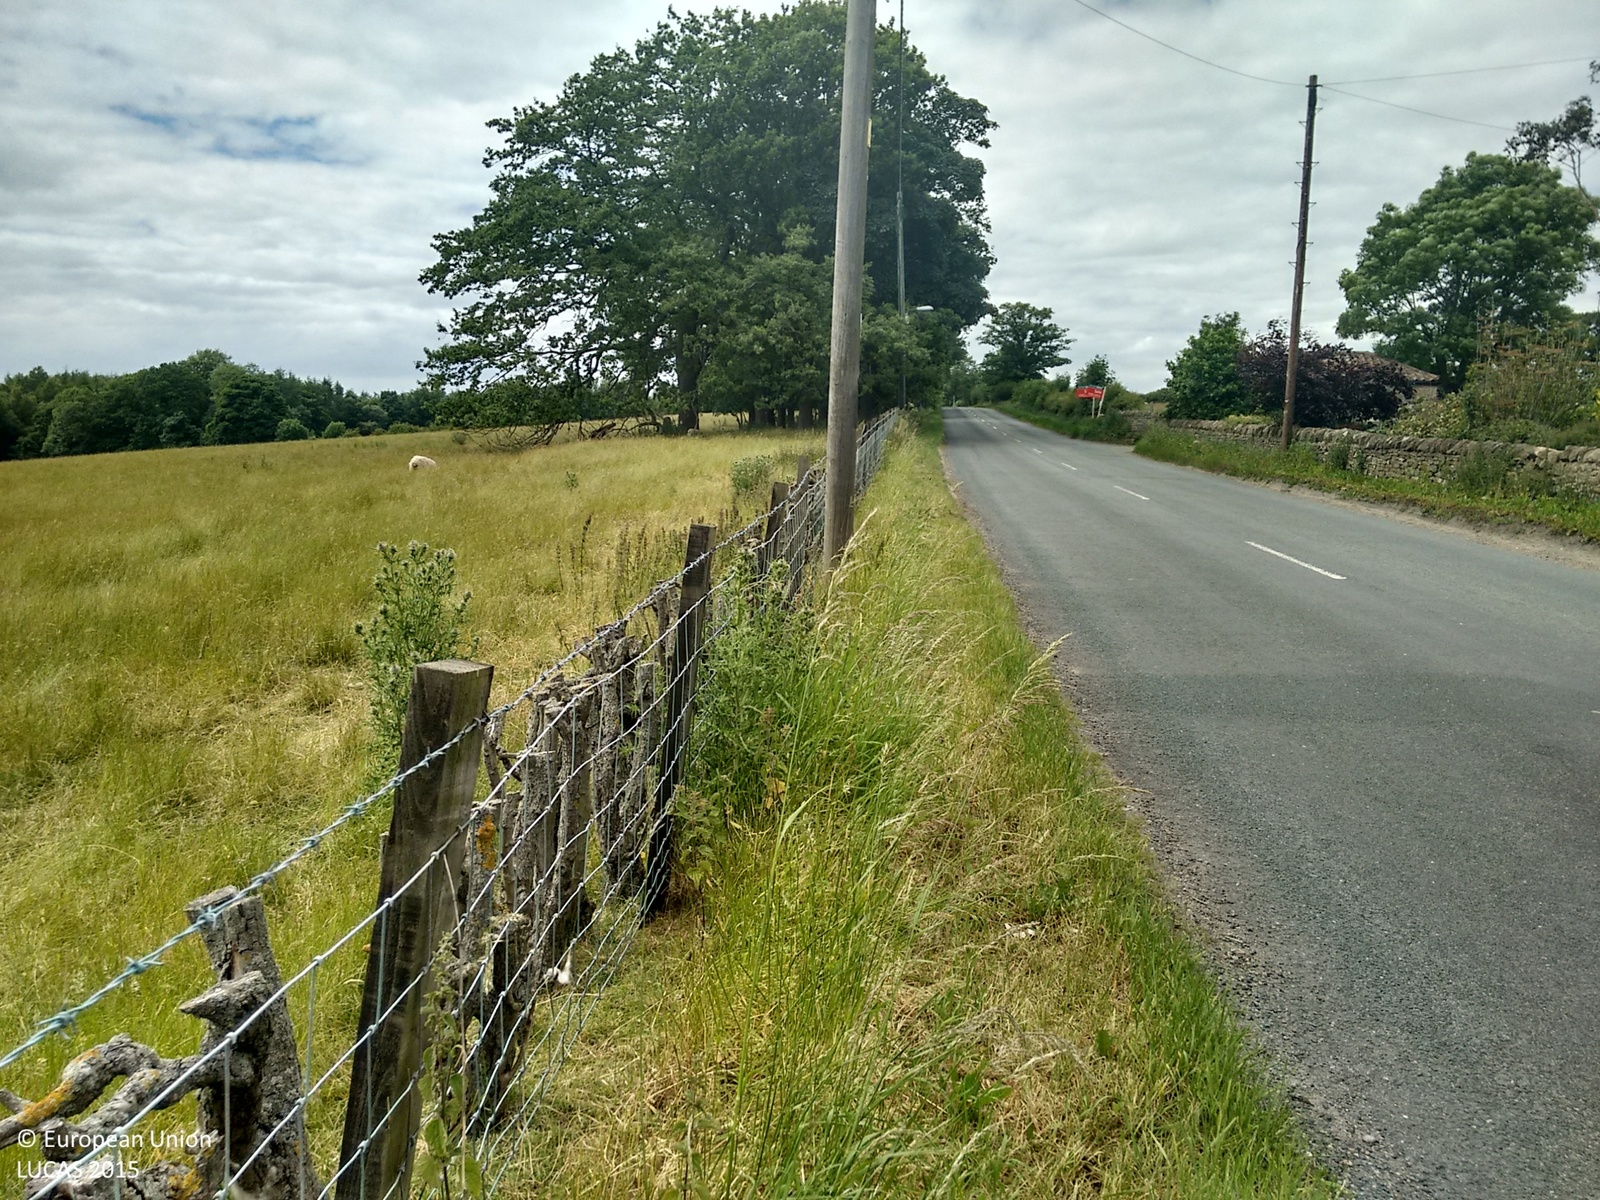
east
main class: Grassland
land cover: Grassland without tree/shrub cover
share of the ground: > 75 %
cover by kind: herbaceous plants 100 %
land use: Agriculture (excluding fallow land and kitchen gardens)
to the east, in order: Grassland without tree/shrub cover; Abandoned hedges; Grassland without tree/shrub cover
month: June
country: GB
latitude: 54.6984
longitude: -1.7670
